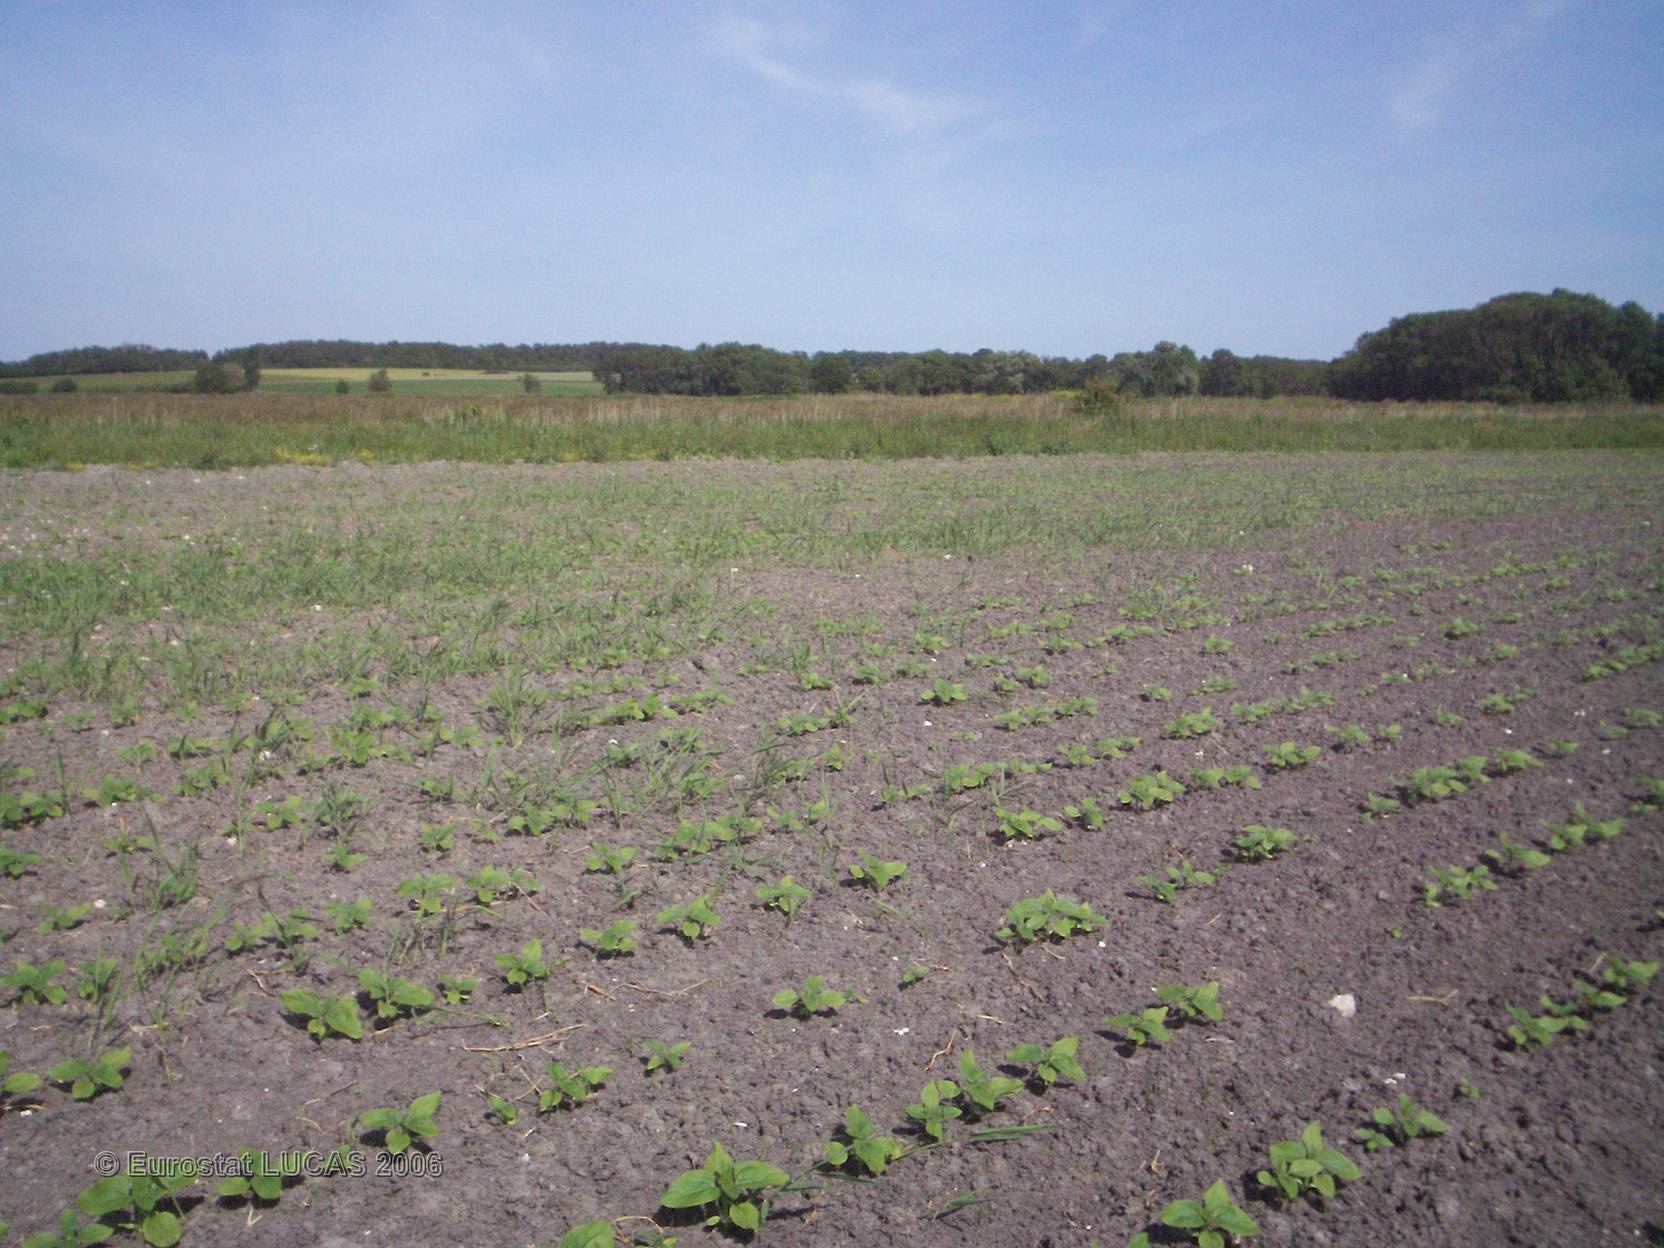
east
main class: Cropland
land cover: Sunflower
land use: Agriculture (excluding fallow land and kitchen gardens)
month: June
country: FR
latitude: 45.7003
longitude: -1.0867
